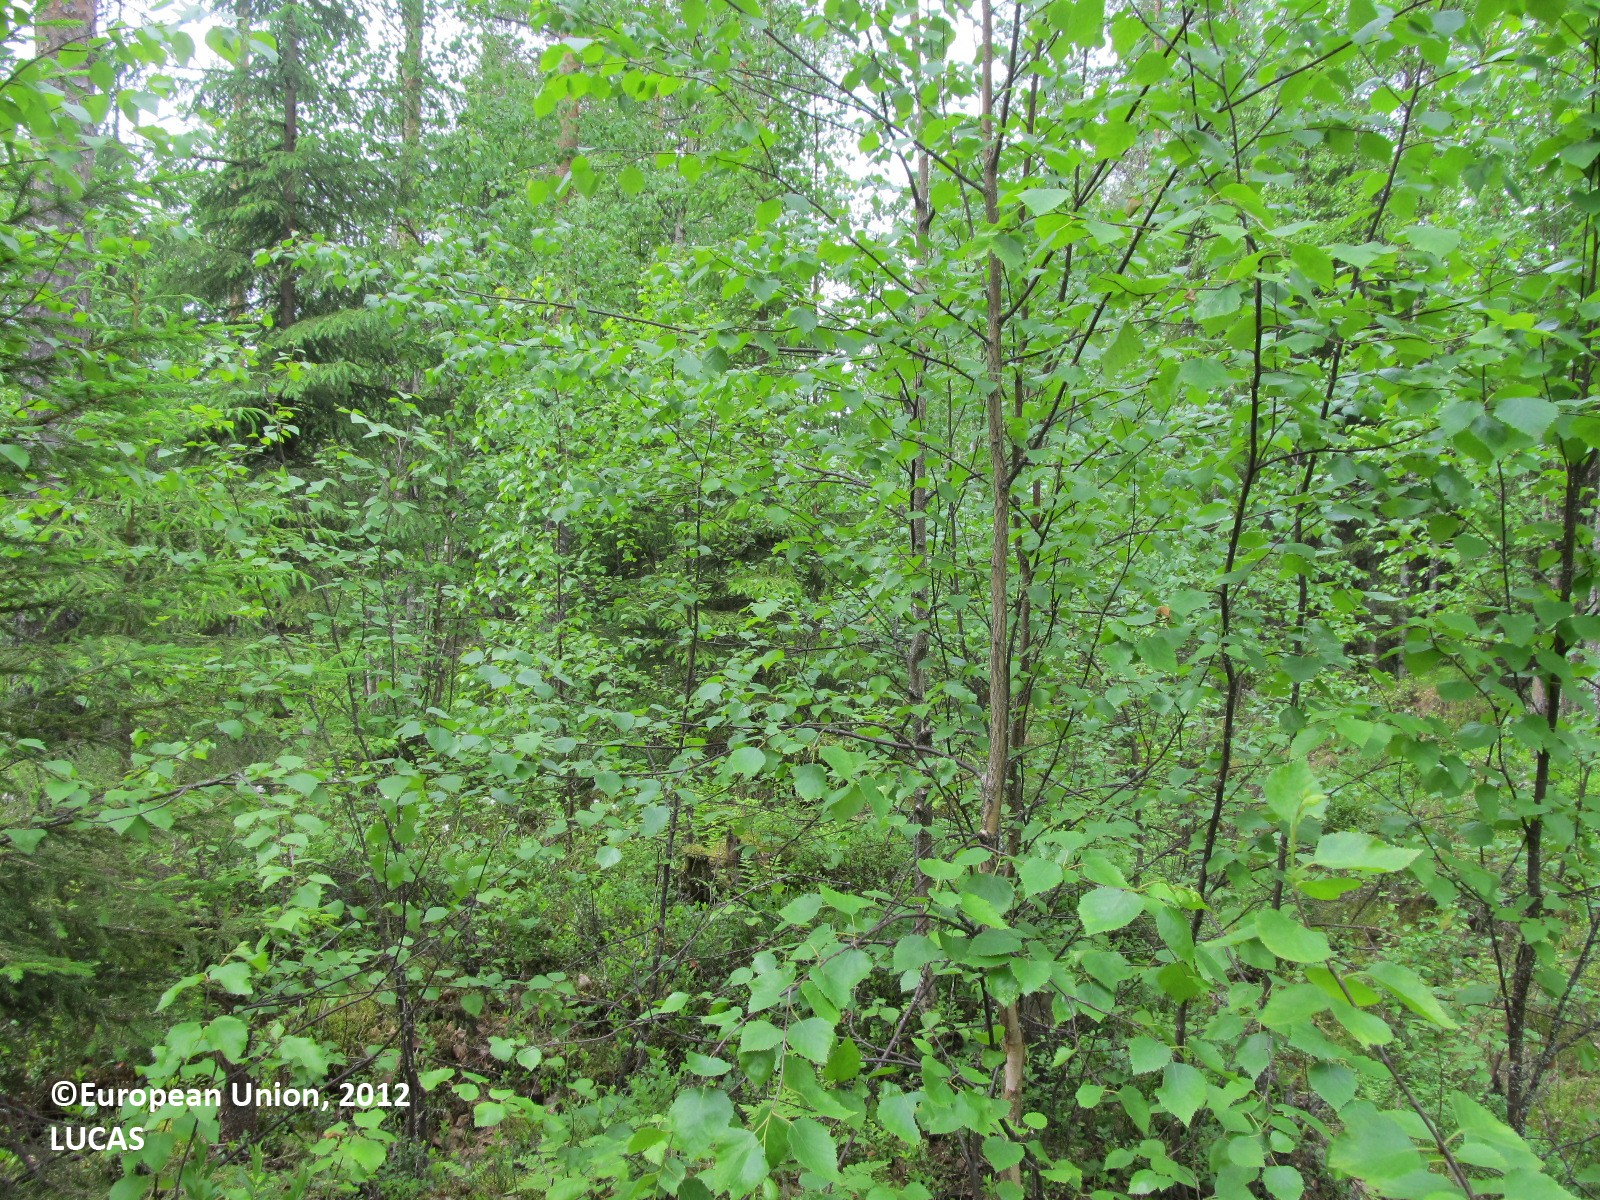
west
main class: Woodland
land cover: Pine dominated mixed woodland
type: boreal forest
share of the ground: 50 - 75 %
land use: Forestry
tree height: > 5 m
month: June
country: FI
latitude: 62.8211
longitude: 28.9958
